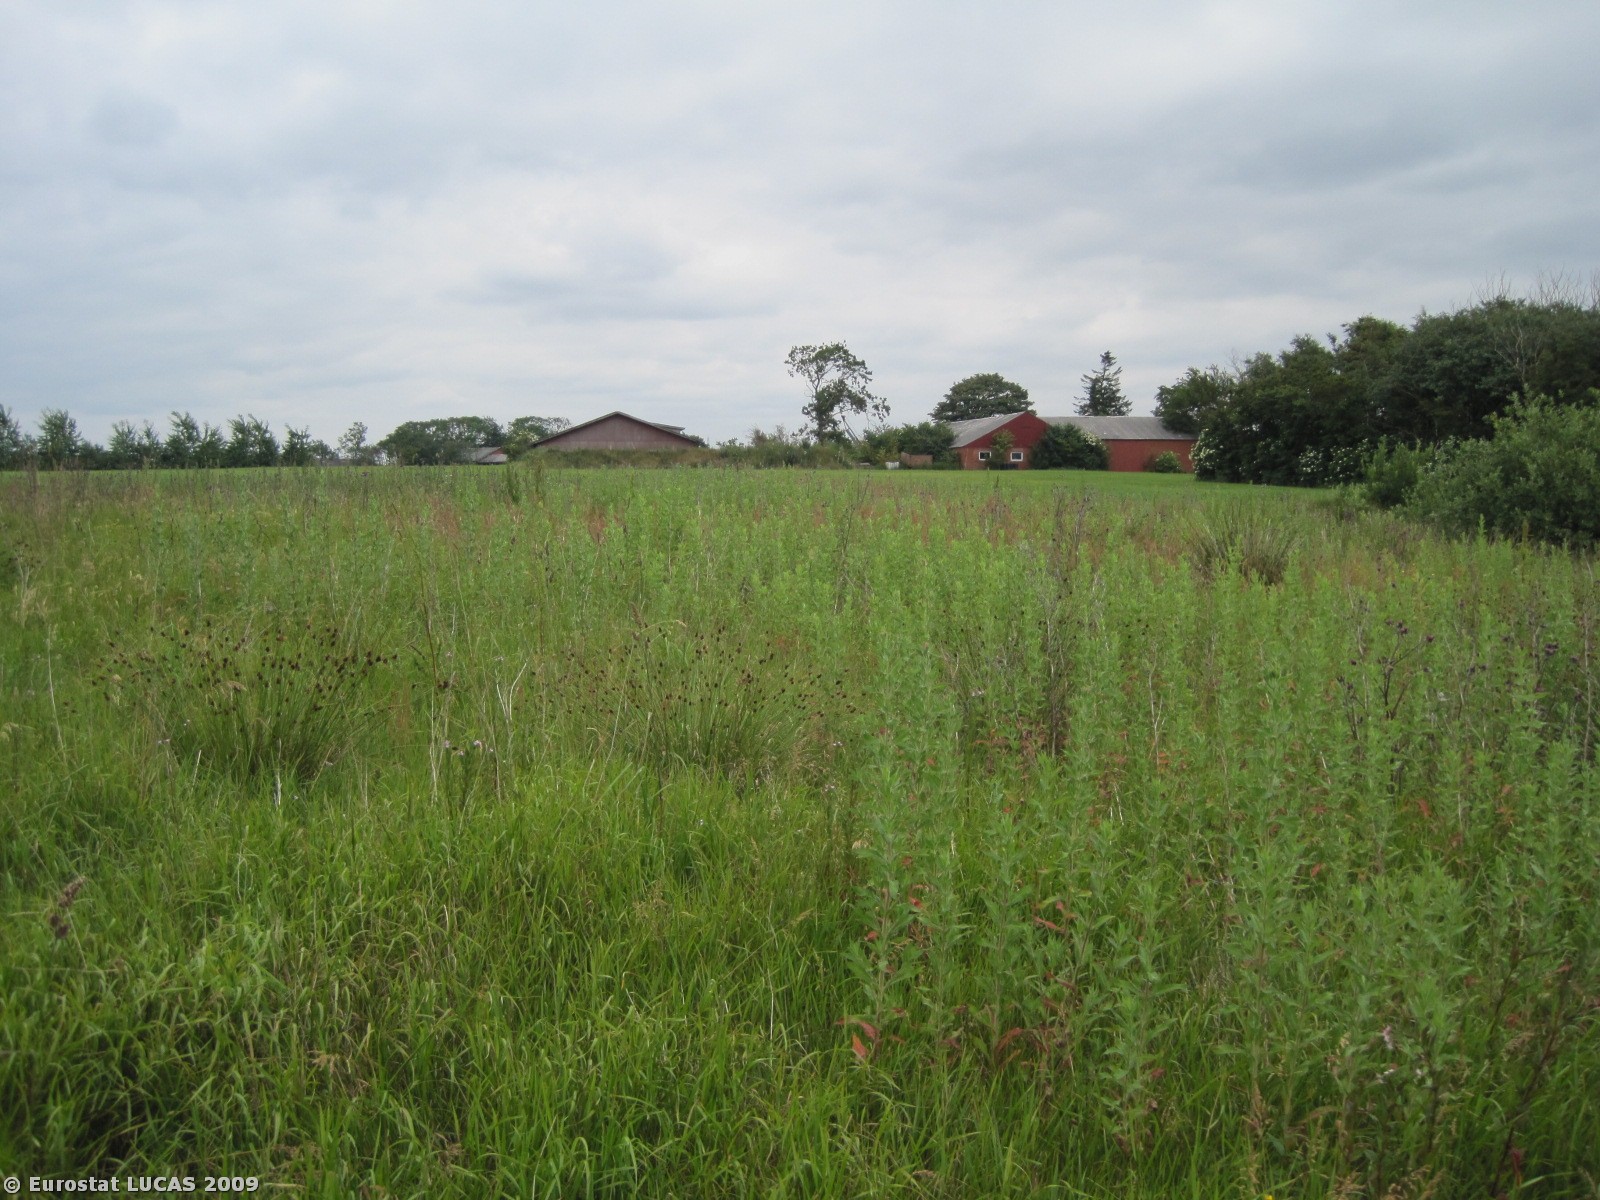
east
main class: Grassland
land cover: Grassland without tree/shrub cover
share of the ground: > 75 %
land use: Unused
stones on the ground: < 10 %
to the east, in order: Grassland without tree/shrub cover; Barley; Grassland without tree/shrub cover; Artificial constructions in urban areas; Grassland without tree/shrub cover; Barley
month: June
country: DK
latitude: 56.3411
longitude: 8.5296
